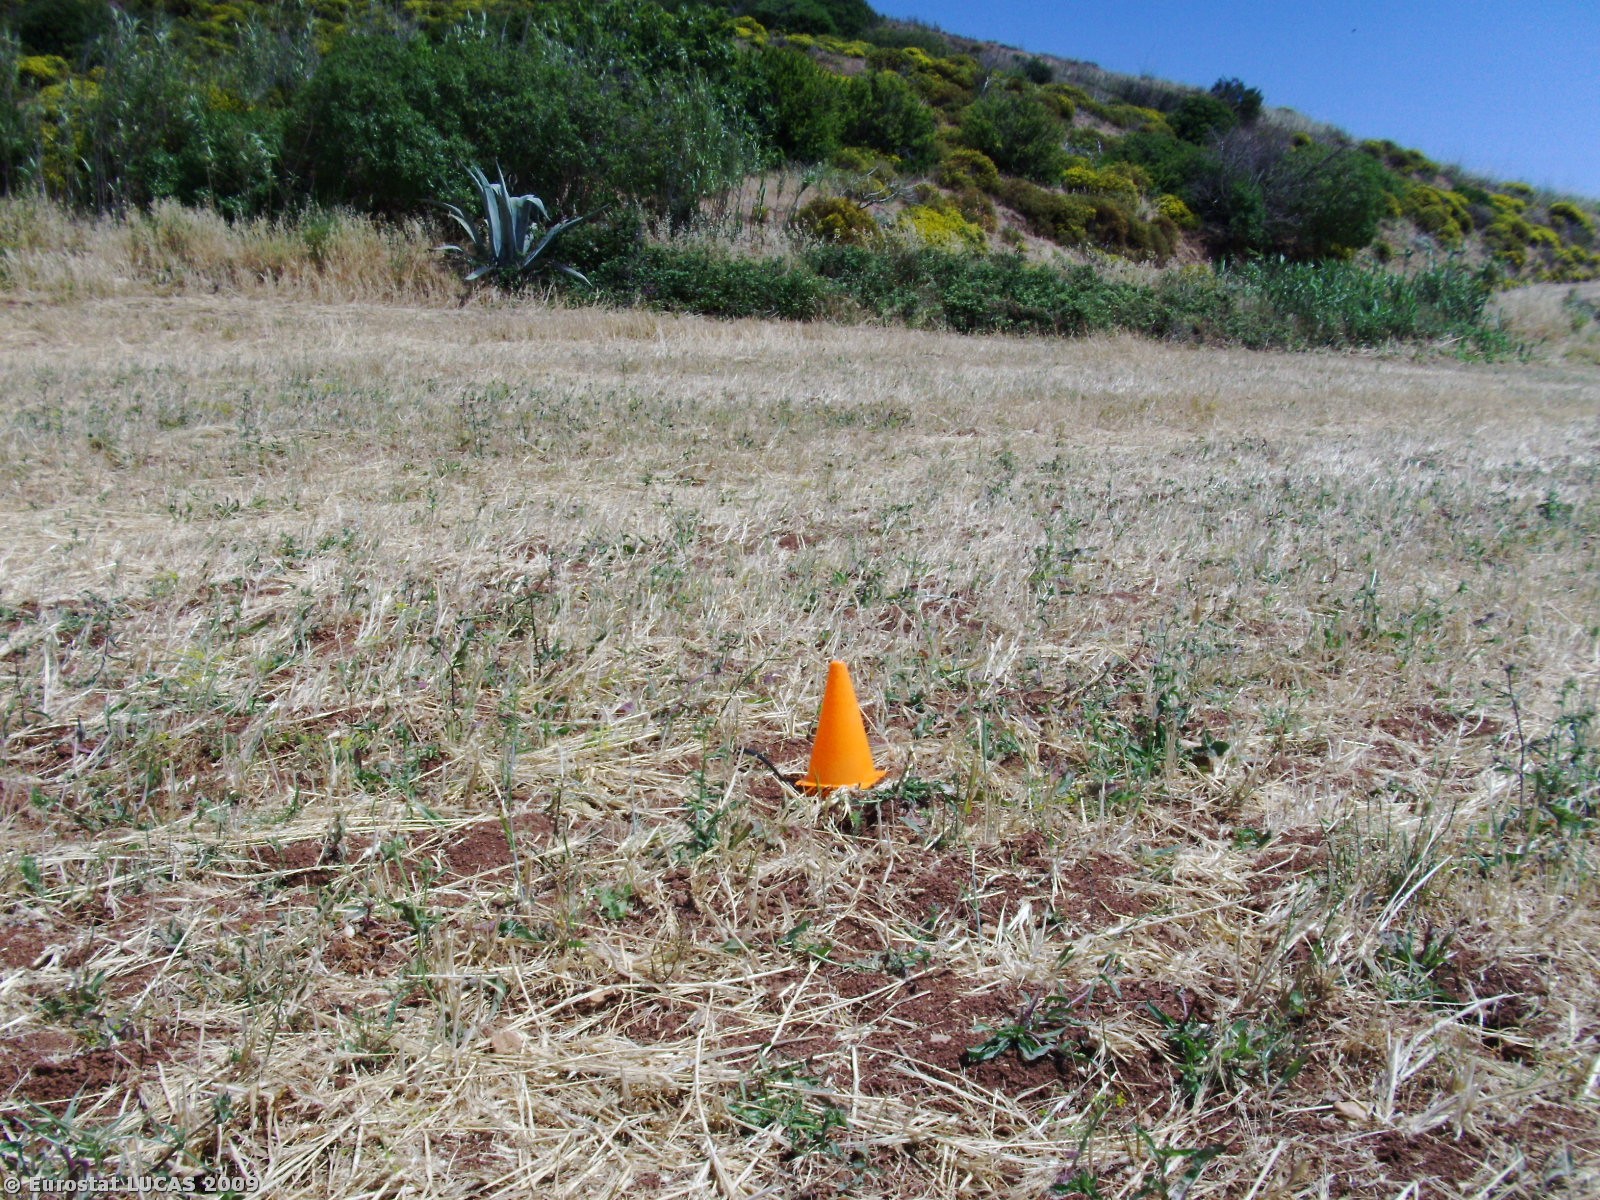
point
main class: Grassland
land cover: Spontaneously vegetated surfaces
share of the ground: > 75 %
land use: Fallow land
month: June
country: PT
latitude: 37.0818
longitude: -8.8749
